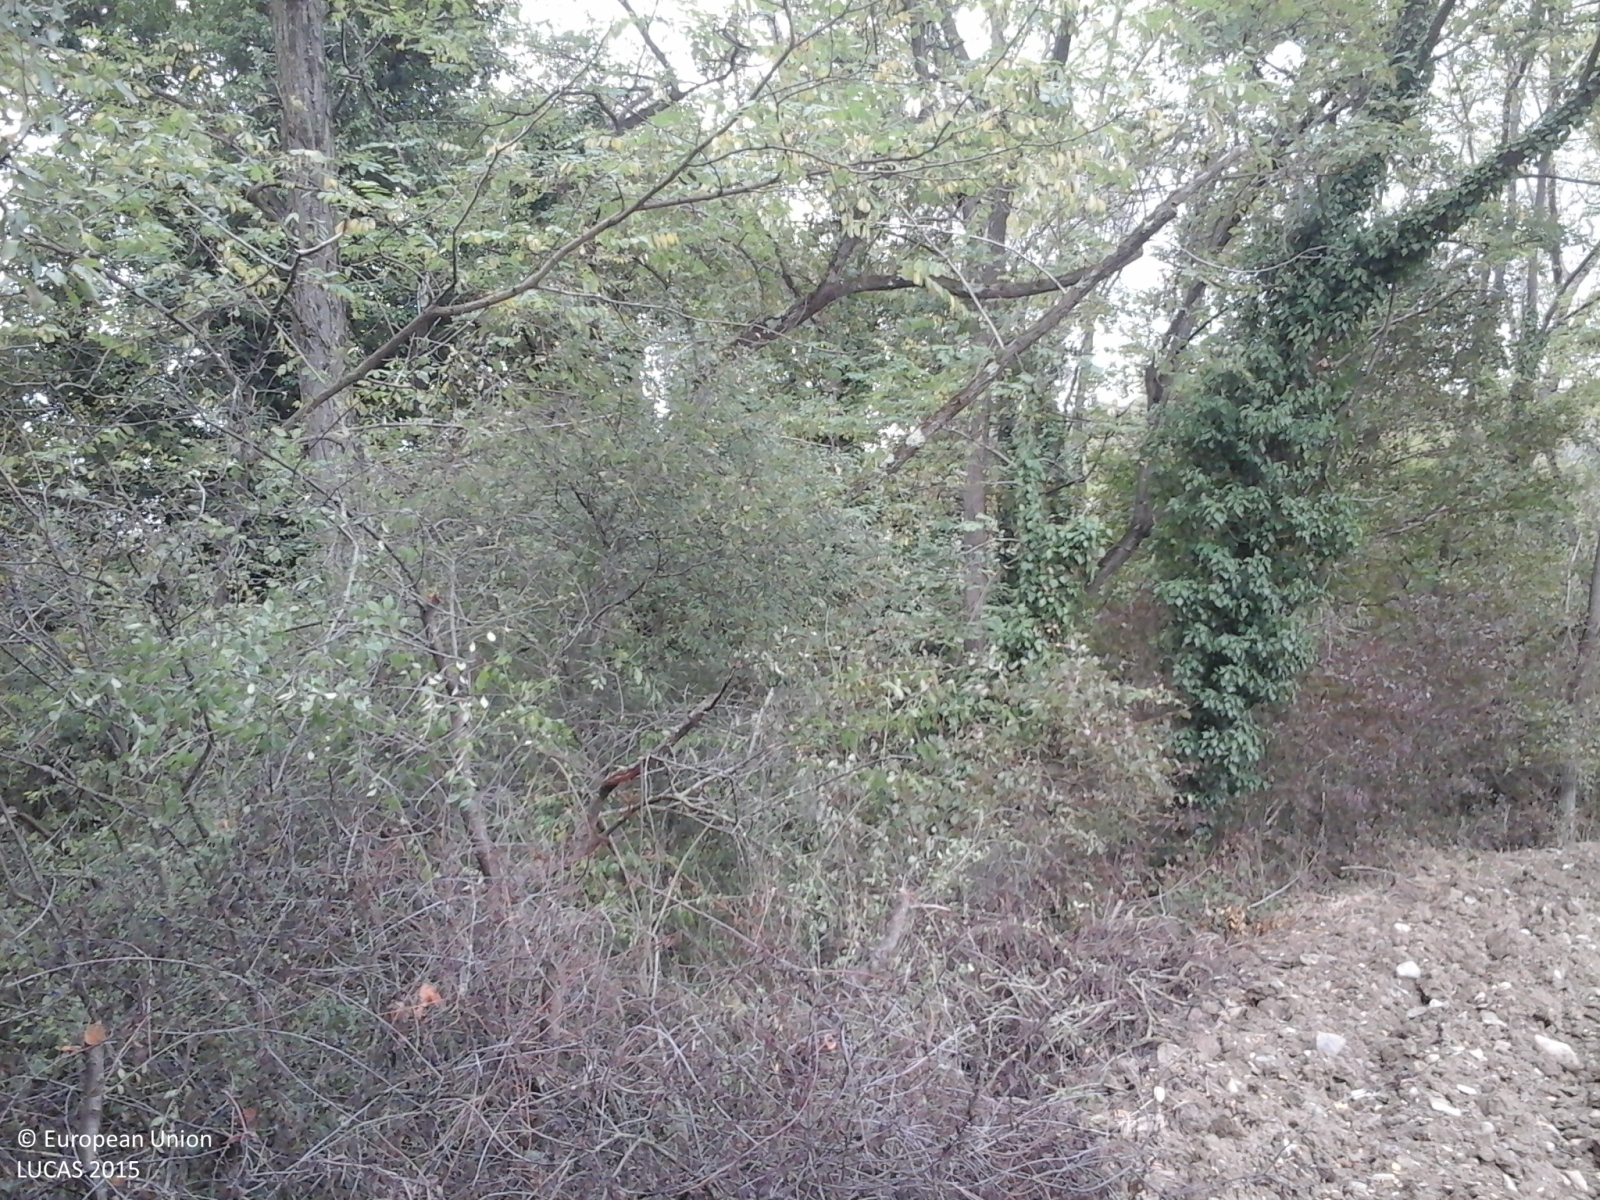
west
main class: Woodland
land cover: Broadleaved woodland
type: thermophilous deciduous forest
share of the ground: > 75 %
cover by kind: broadleaved forest trees 80 %, shrubs 15 %, herbaceous plants 5 %
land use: Forestry
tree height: > 5 m
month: October
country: IT
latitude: 43.3312
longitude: 12.3492
